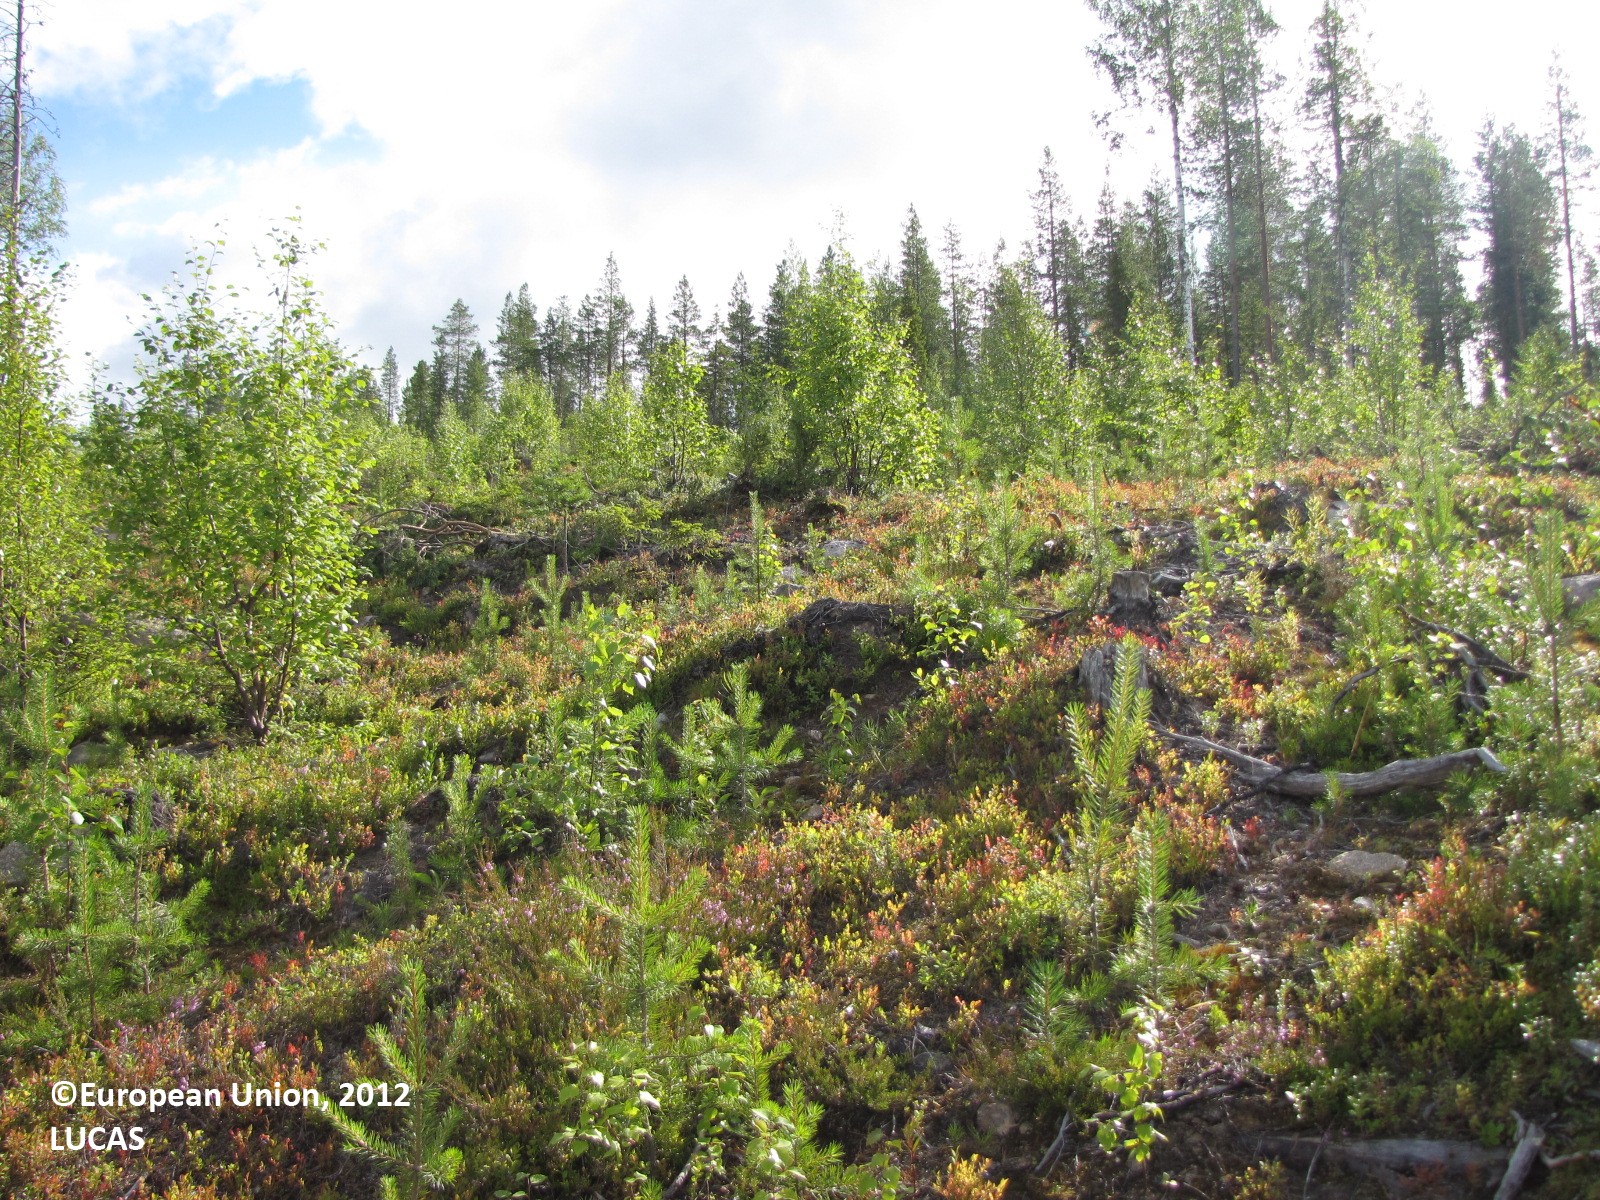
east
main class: Woodland
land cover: Pine dominated mixed woodland
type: boreal forest
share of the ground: 10 - 25 %
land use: Forestry
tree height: < 5 m
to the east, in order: Pine dominated mixed woodland; Pine dominated coniferous woodland; Tracks; Pine dominated coniferous woodland; Pine dominated mixed woodland
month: August
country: FI
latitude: 66.8699
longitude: 24.6655
